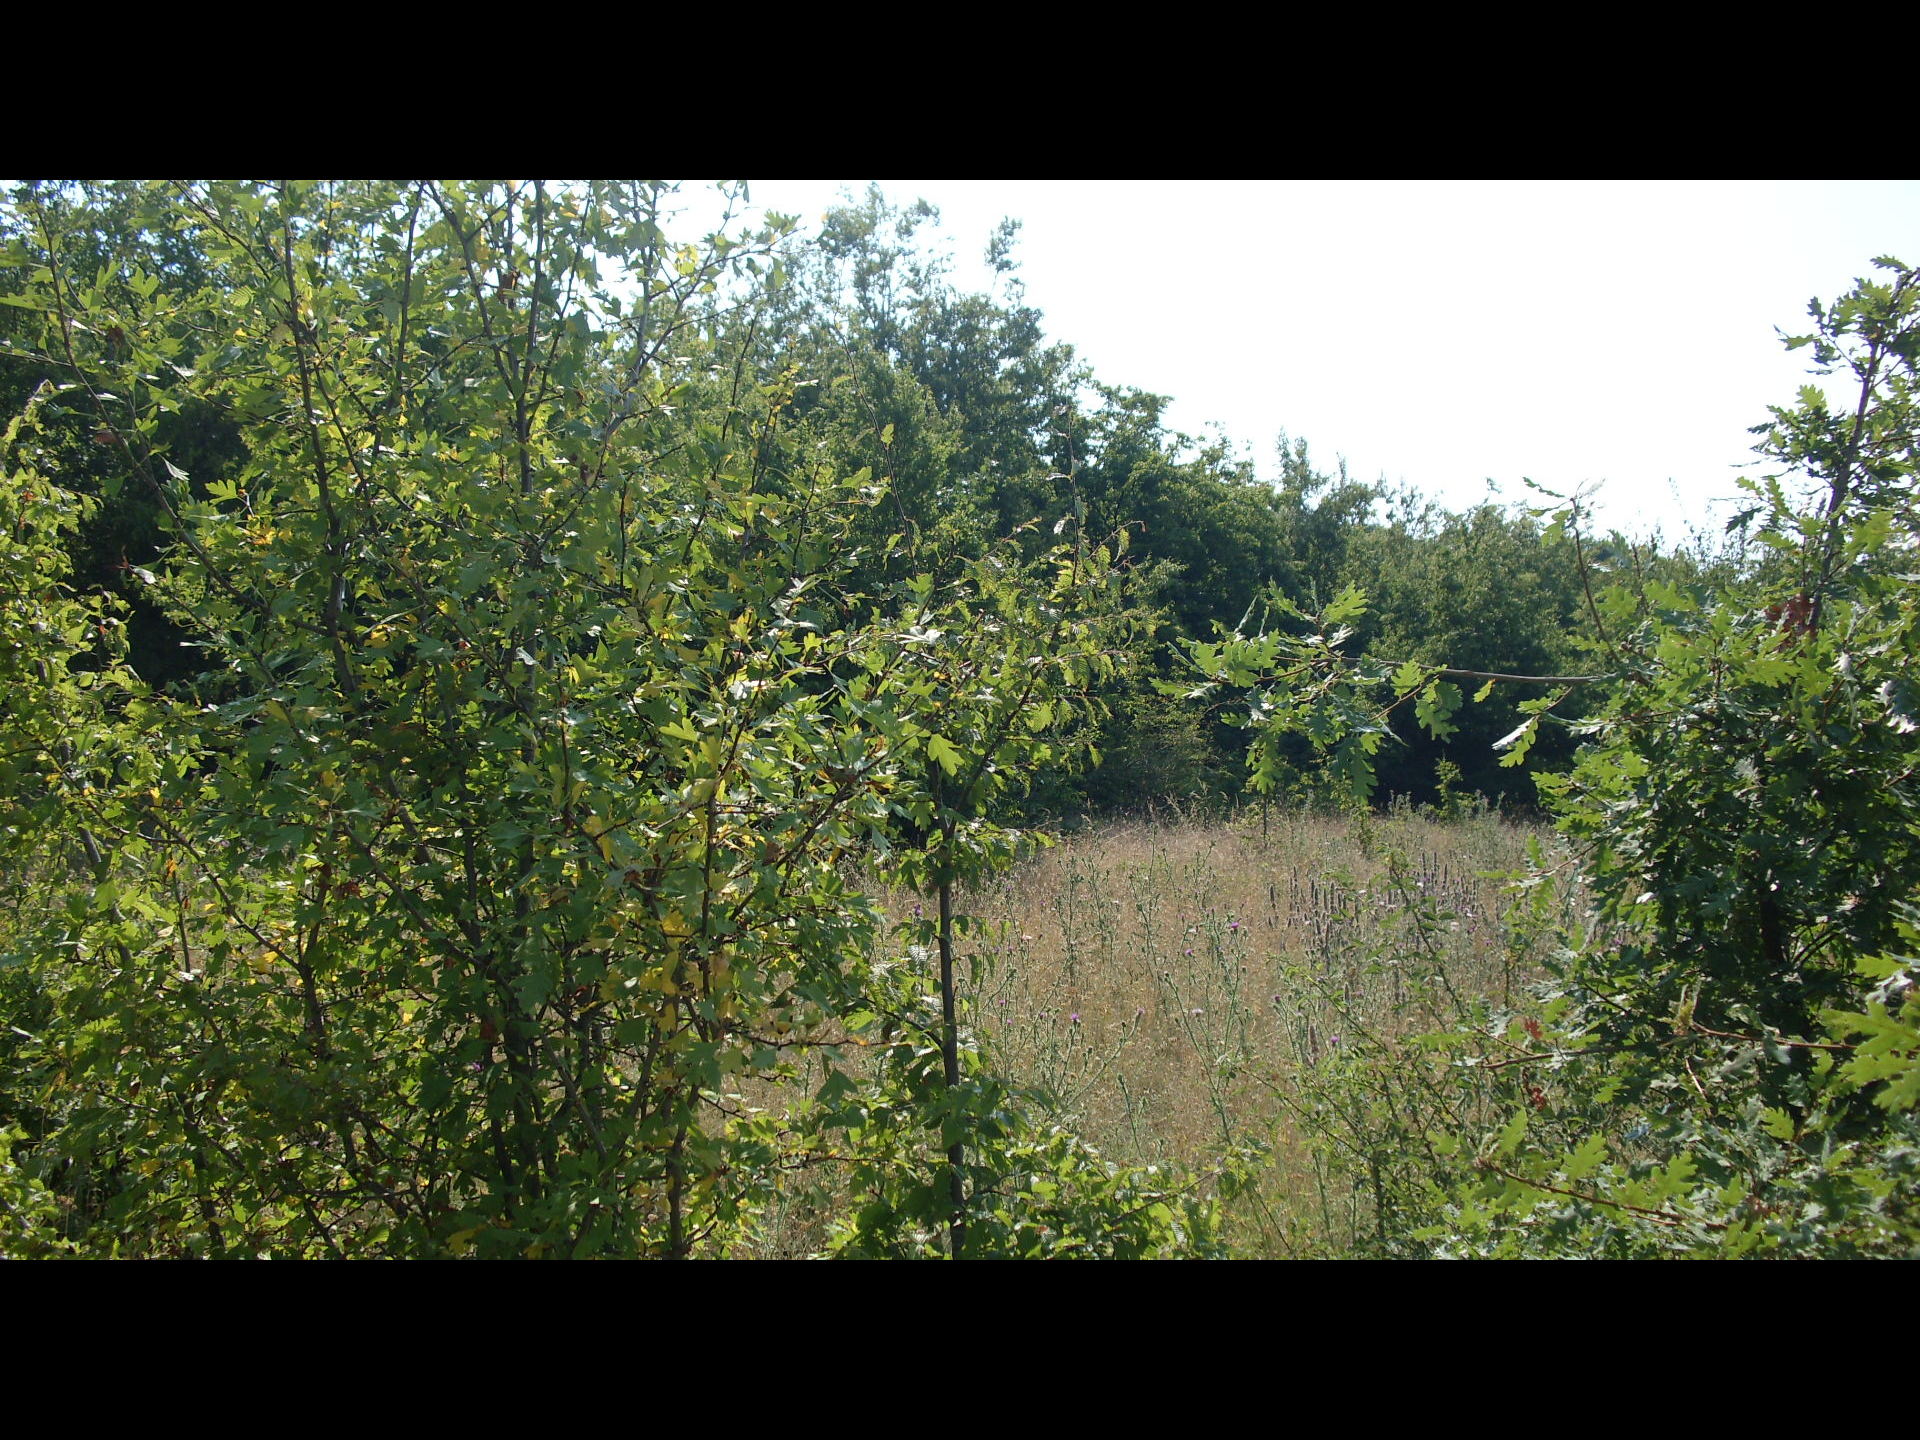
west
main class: Woodland
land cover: Broadleaved woodland
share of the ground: 25 - 50 %
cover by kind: herbaceous plants 50 %, broadleaved forest trees 25 %, shrubs 25 %
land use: Semi-natural and natural areas not in use
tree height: < 5 m
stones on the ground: 10 - 25 %
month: July
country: BG
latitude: 43.6139
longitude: 22.7602
